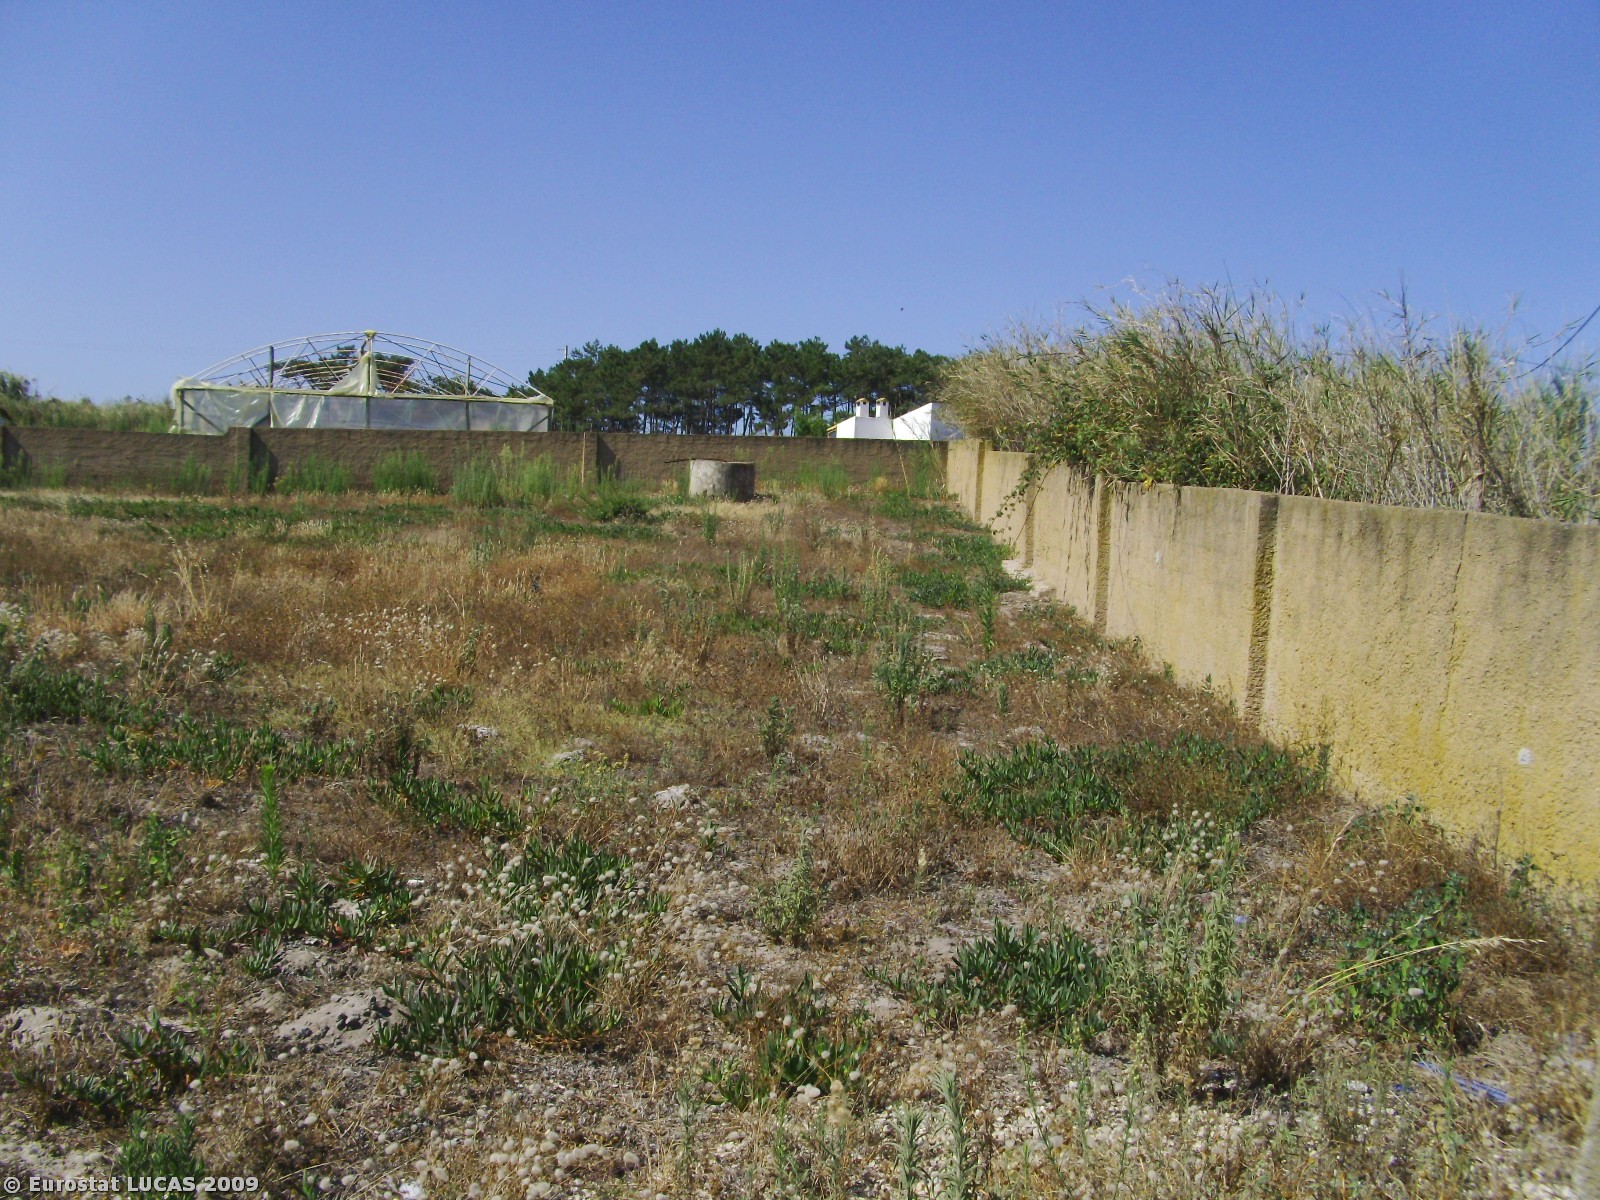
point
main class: Grassland
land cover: Spontaneously vegetated surfaces
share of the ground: > 75 %
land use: Fallow land
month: July
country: PT
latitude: 39.1530
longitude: -9.3573
